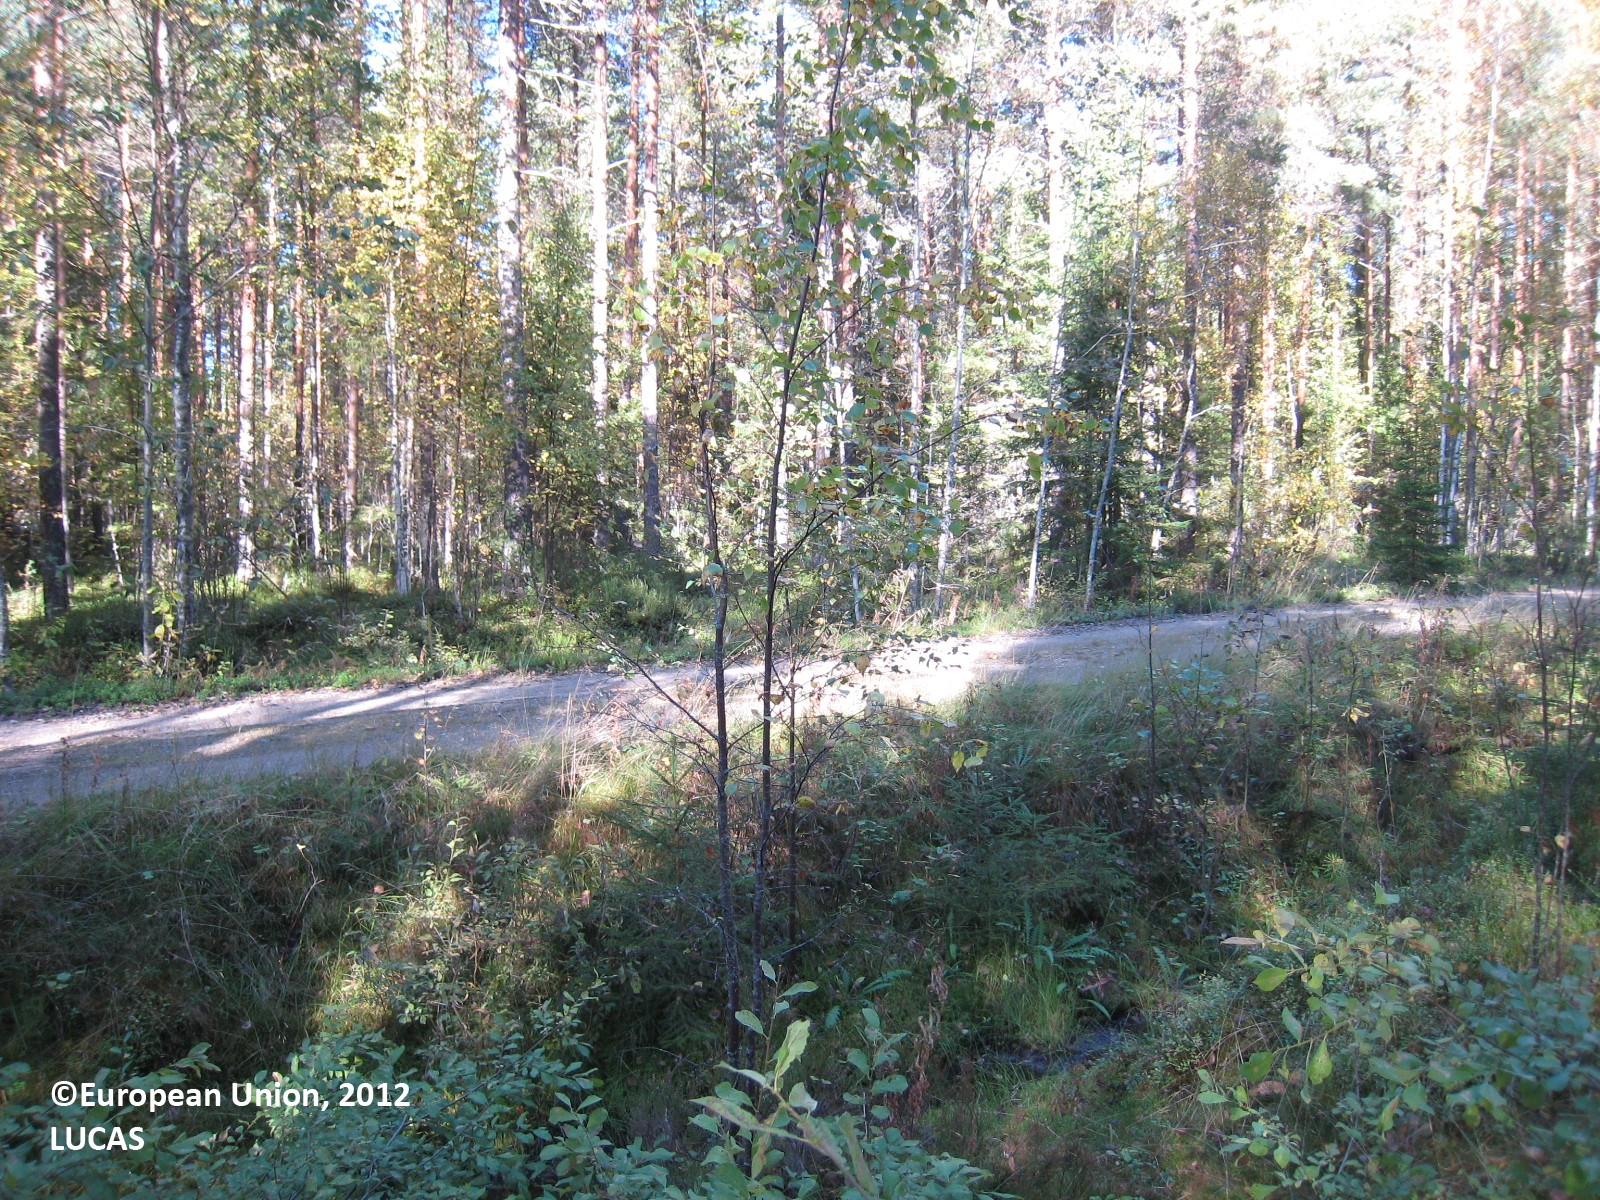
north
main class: Woodland
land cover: Pine dominated mixed woodland
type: boreal forest
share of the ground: > 75 %
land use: Forestry
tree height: > 5 m
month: September
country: FI
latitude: 62.8453
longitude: 26.6149
